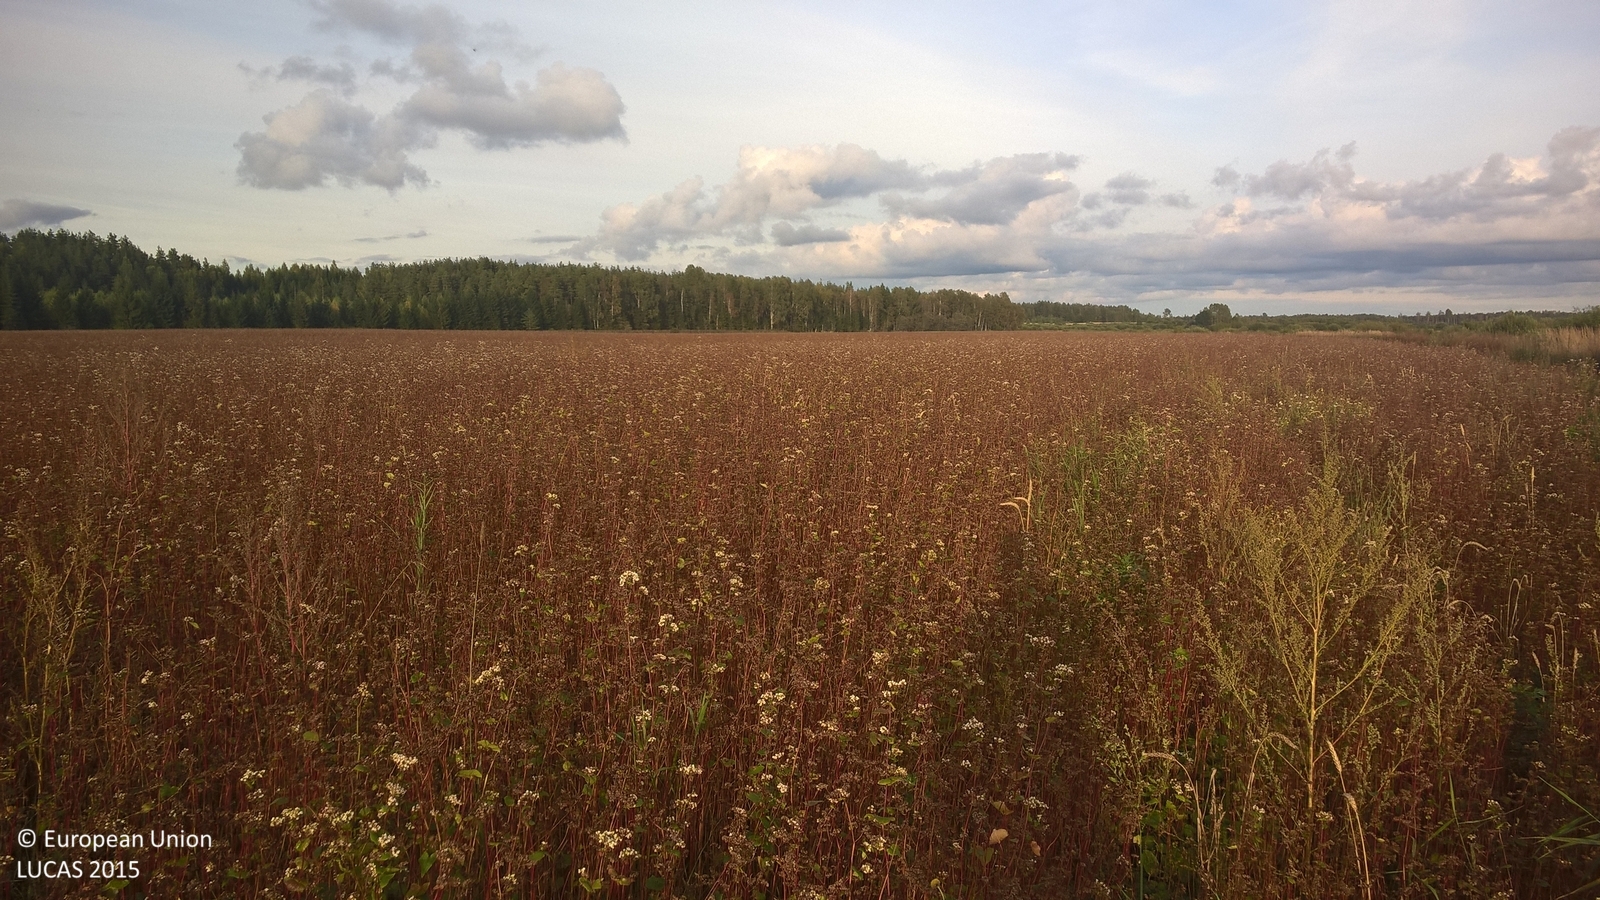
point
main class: Cropland
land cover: Other cereals
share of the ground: > 75 %
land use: Agriculture (excluding fallow land and kitchen gardens)
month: September
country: LV
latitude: 57.8046
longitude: 25.6836
